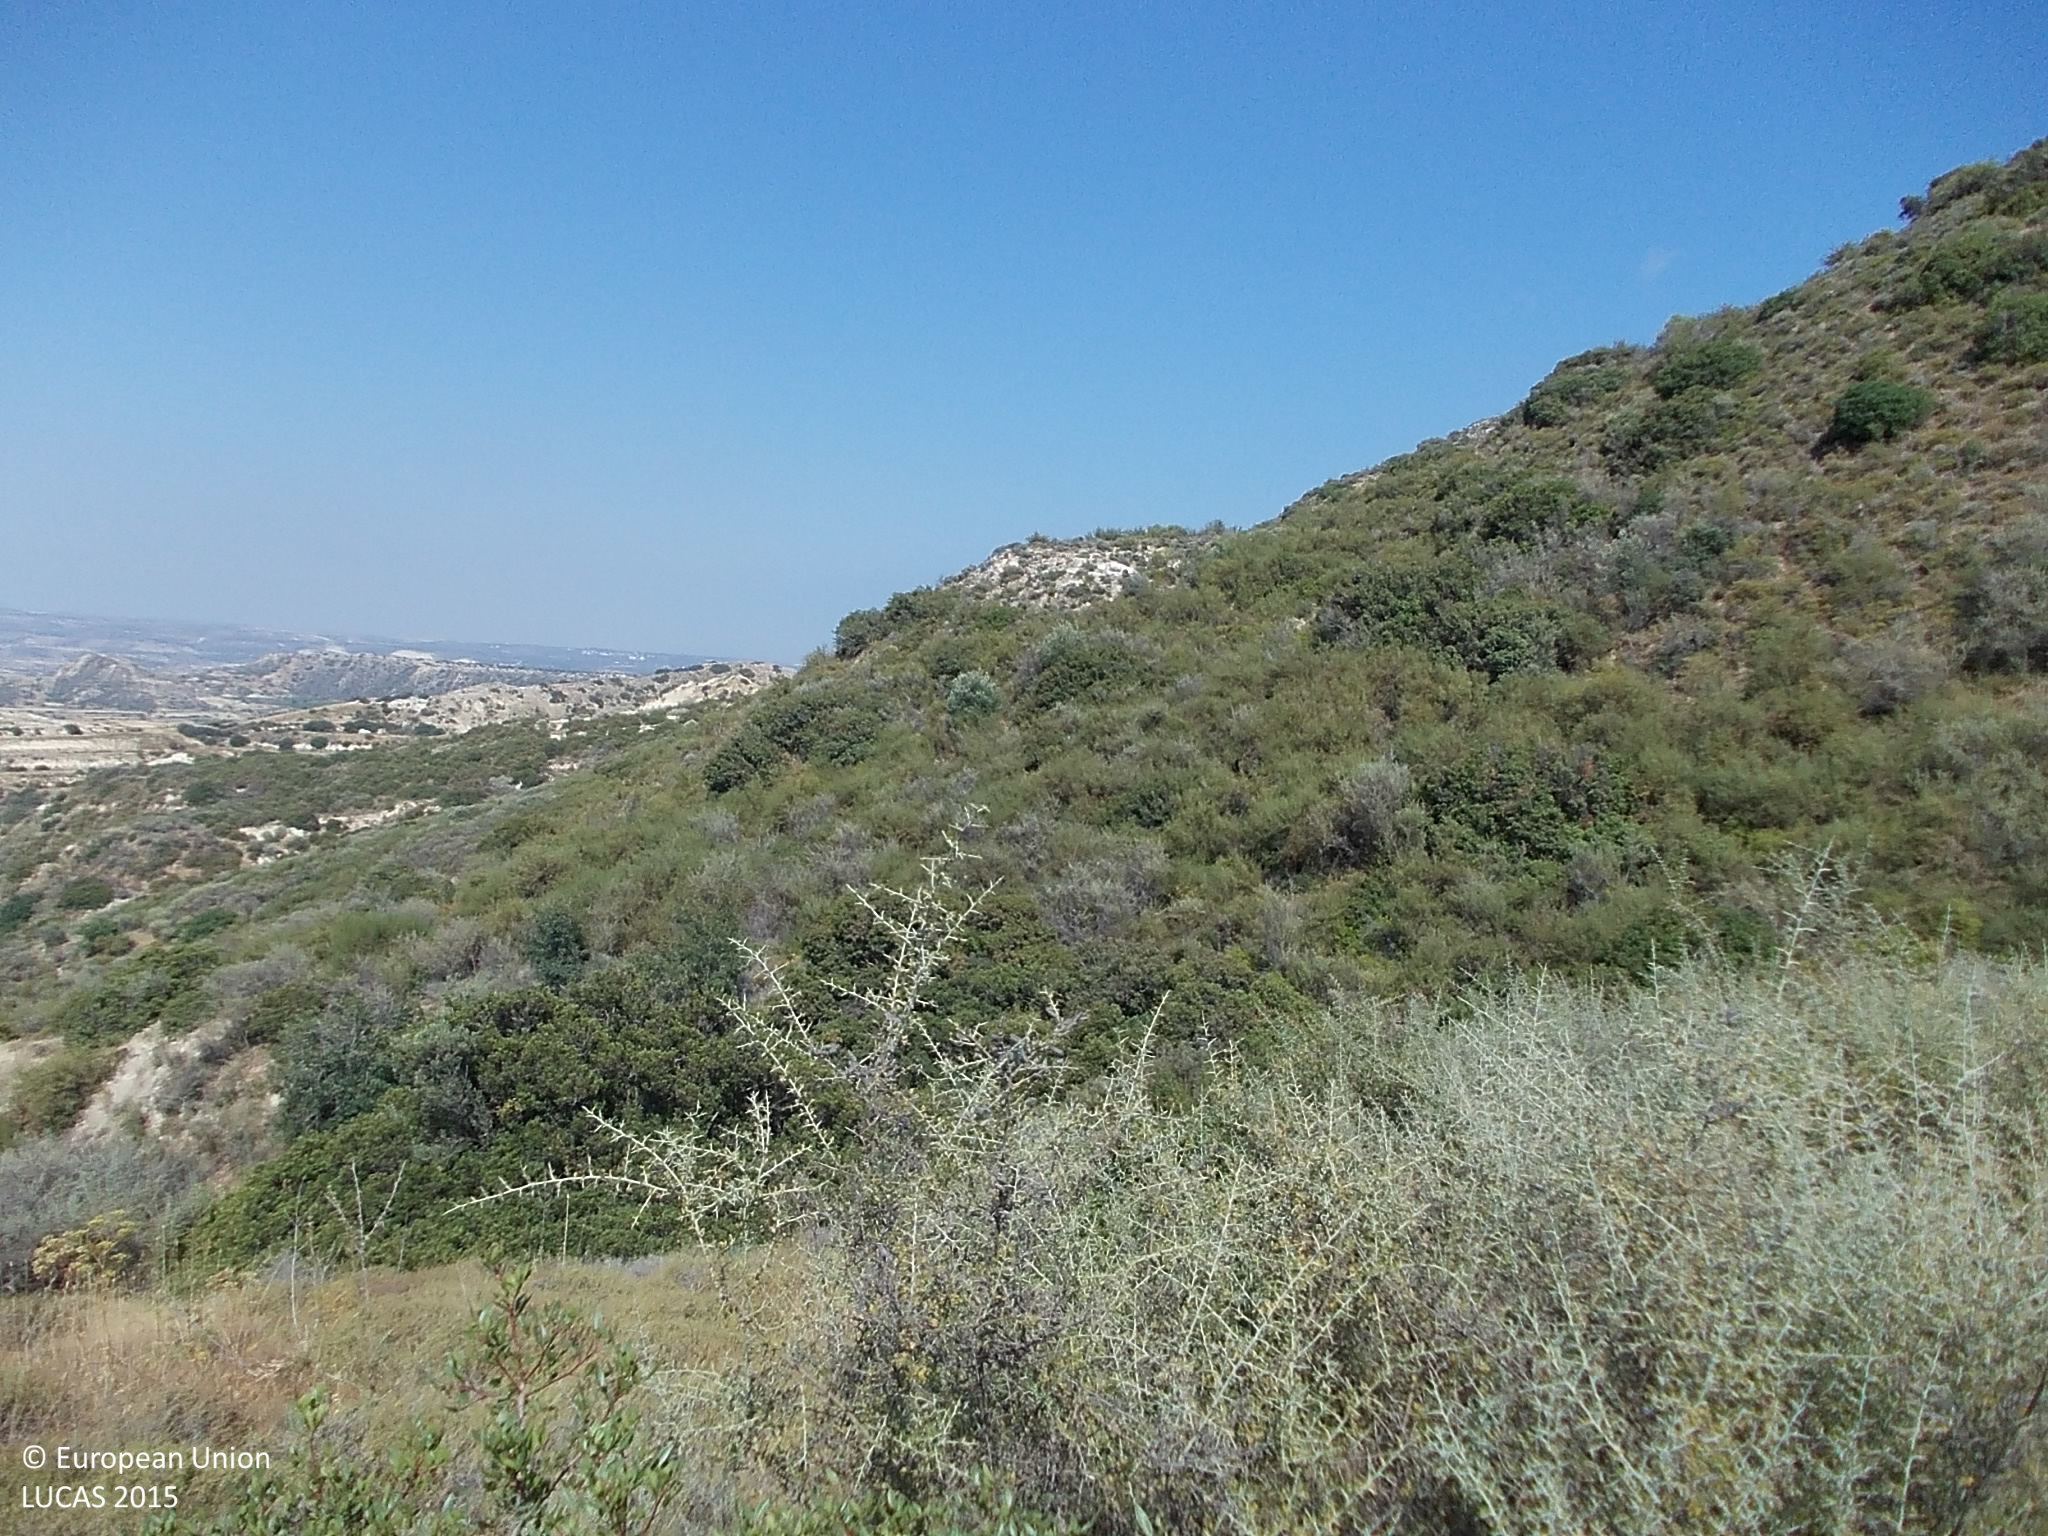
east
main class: Shrubland
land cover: Shrubland without tree cover
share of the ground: > 75 %
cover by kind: shrubs 95 %, herbaceous plants 5 %
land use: Semi-natural and natural areas not in use
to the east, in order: Shrubland without tree cover; Rivers and streams; Shrubland without tree cover
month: June
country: CY
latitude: 34.6623
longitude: 32.7067
